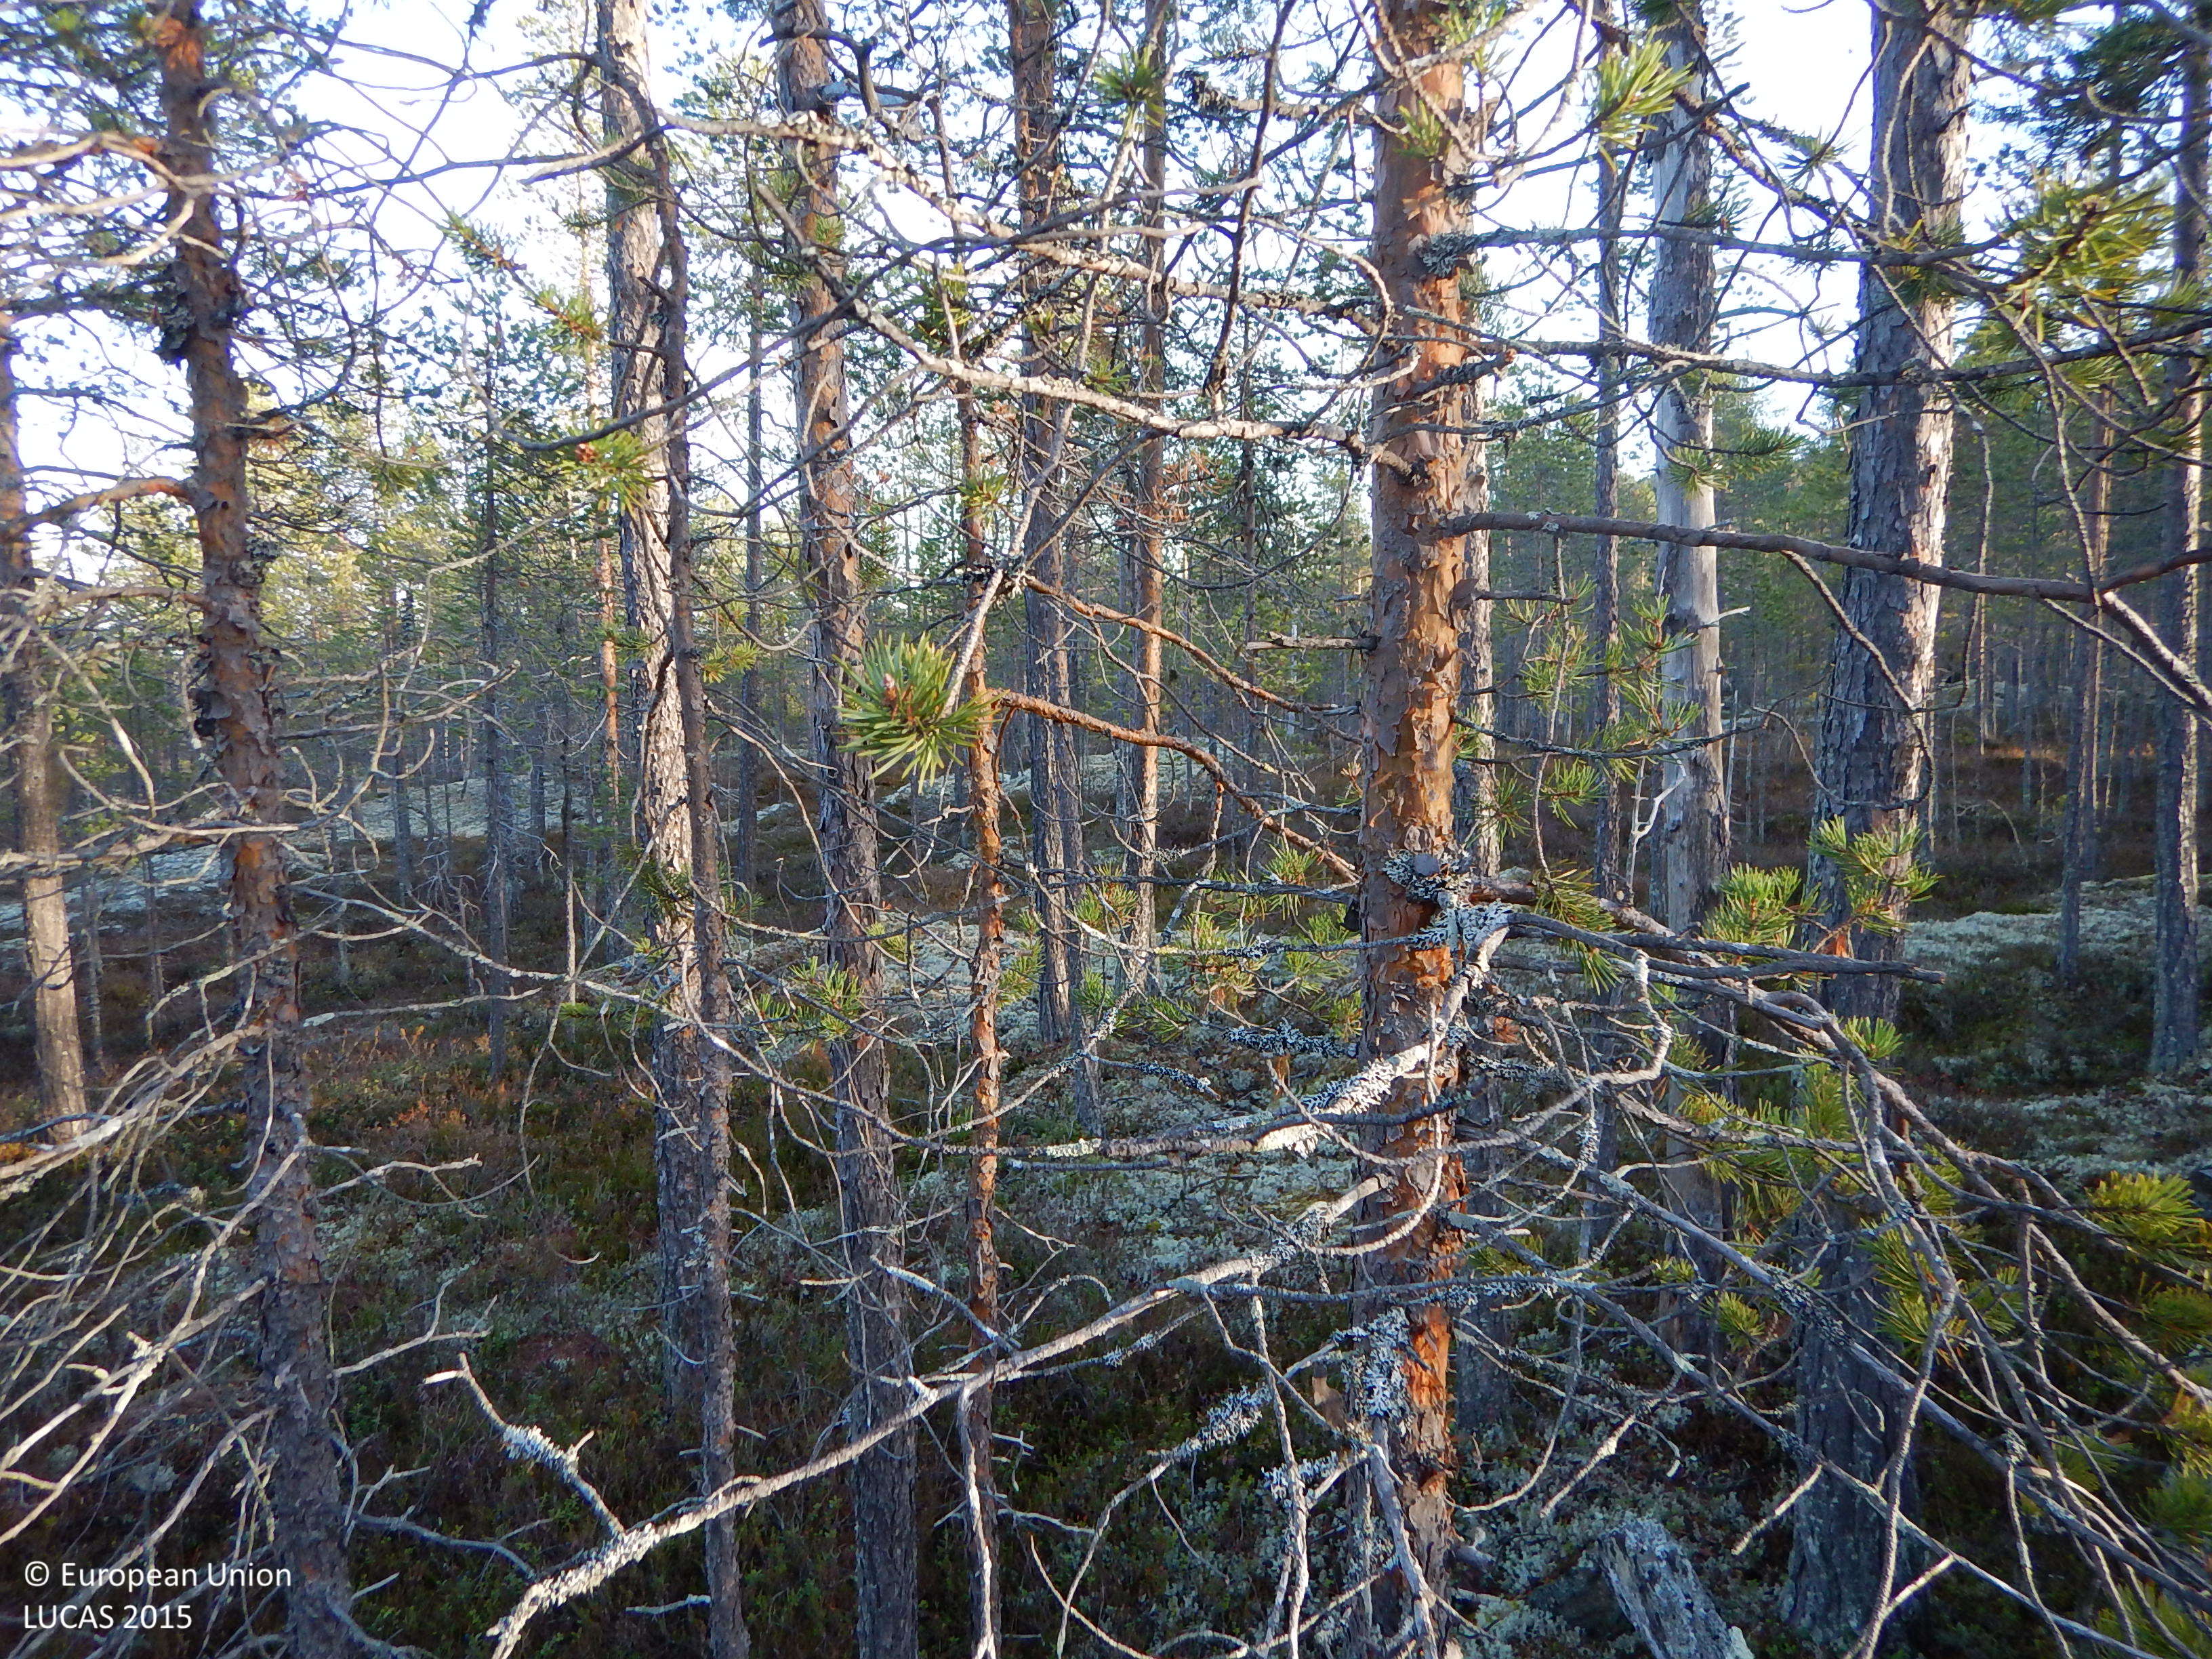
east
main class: Woodland
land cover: Pine dominated coniferous woodland
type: boreal forest
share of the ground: 50 - 75 %
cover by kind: coniferous forest trees 55 %, shrubs 15 %, herbaceous plants 10 %, lichens and mosses 10 %, consolidated bare surface 10 %
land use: Forestry
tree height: > 5 m
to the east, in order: Pine dominated coniferous woodland
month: October
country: SE
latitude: 65.2713
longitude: 20.2300
